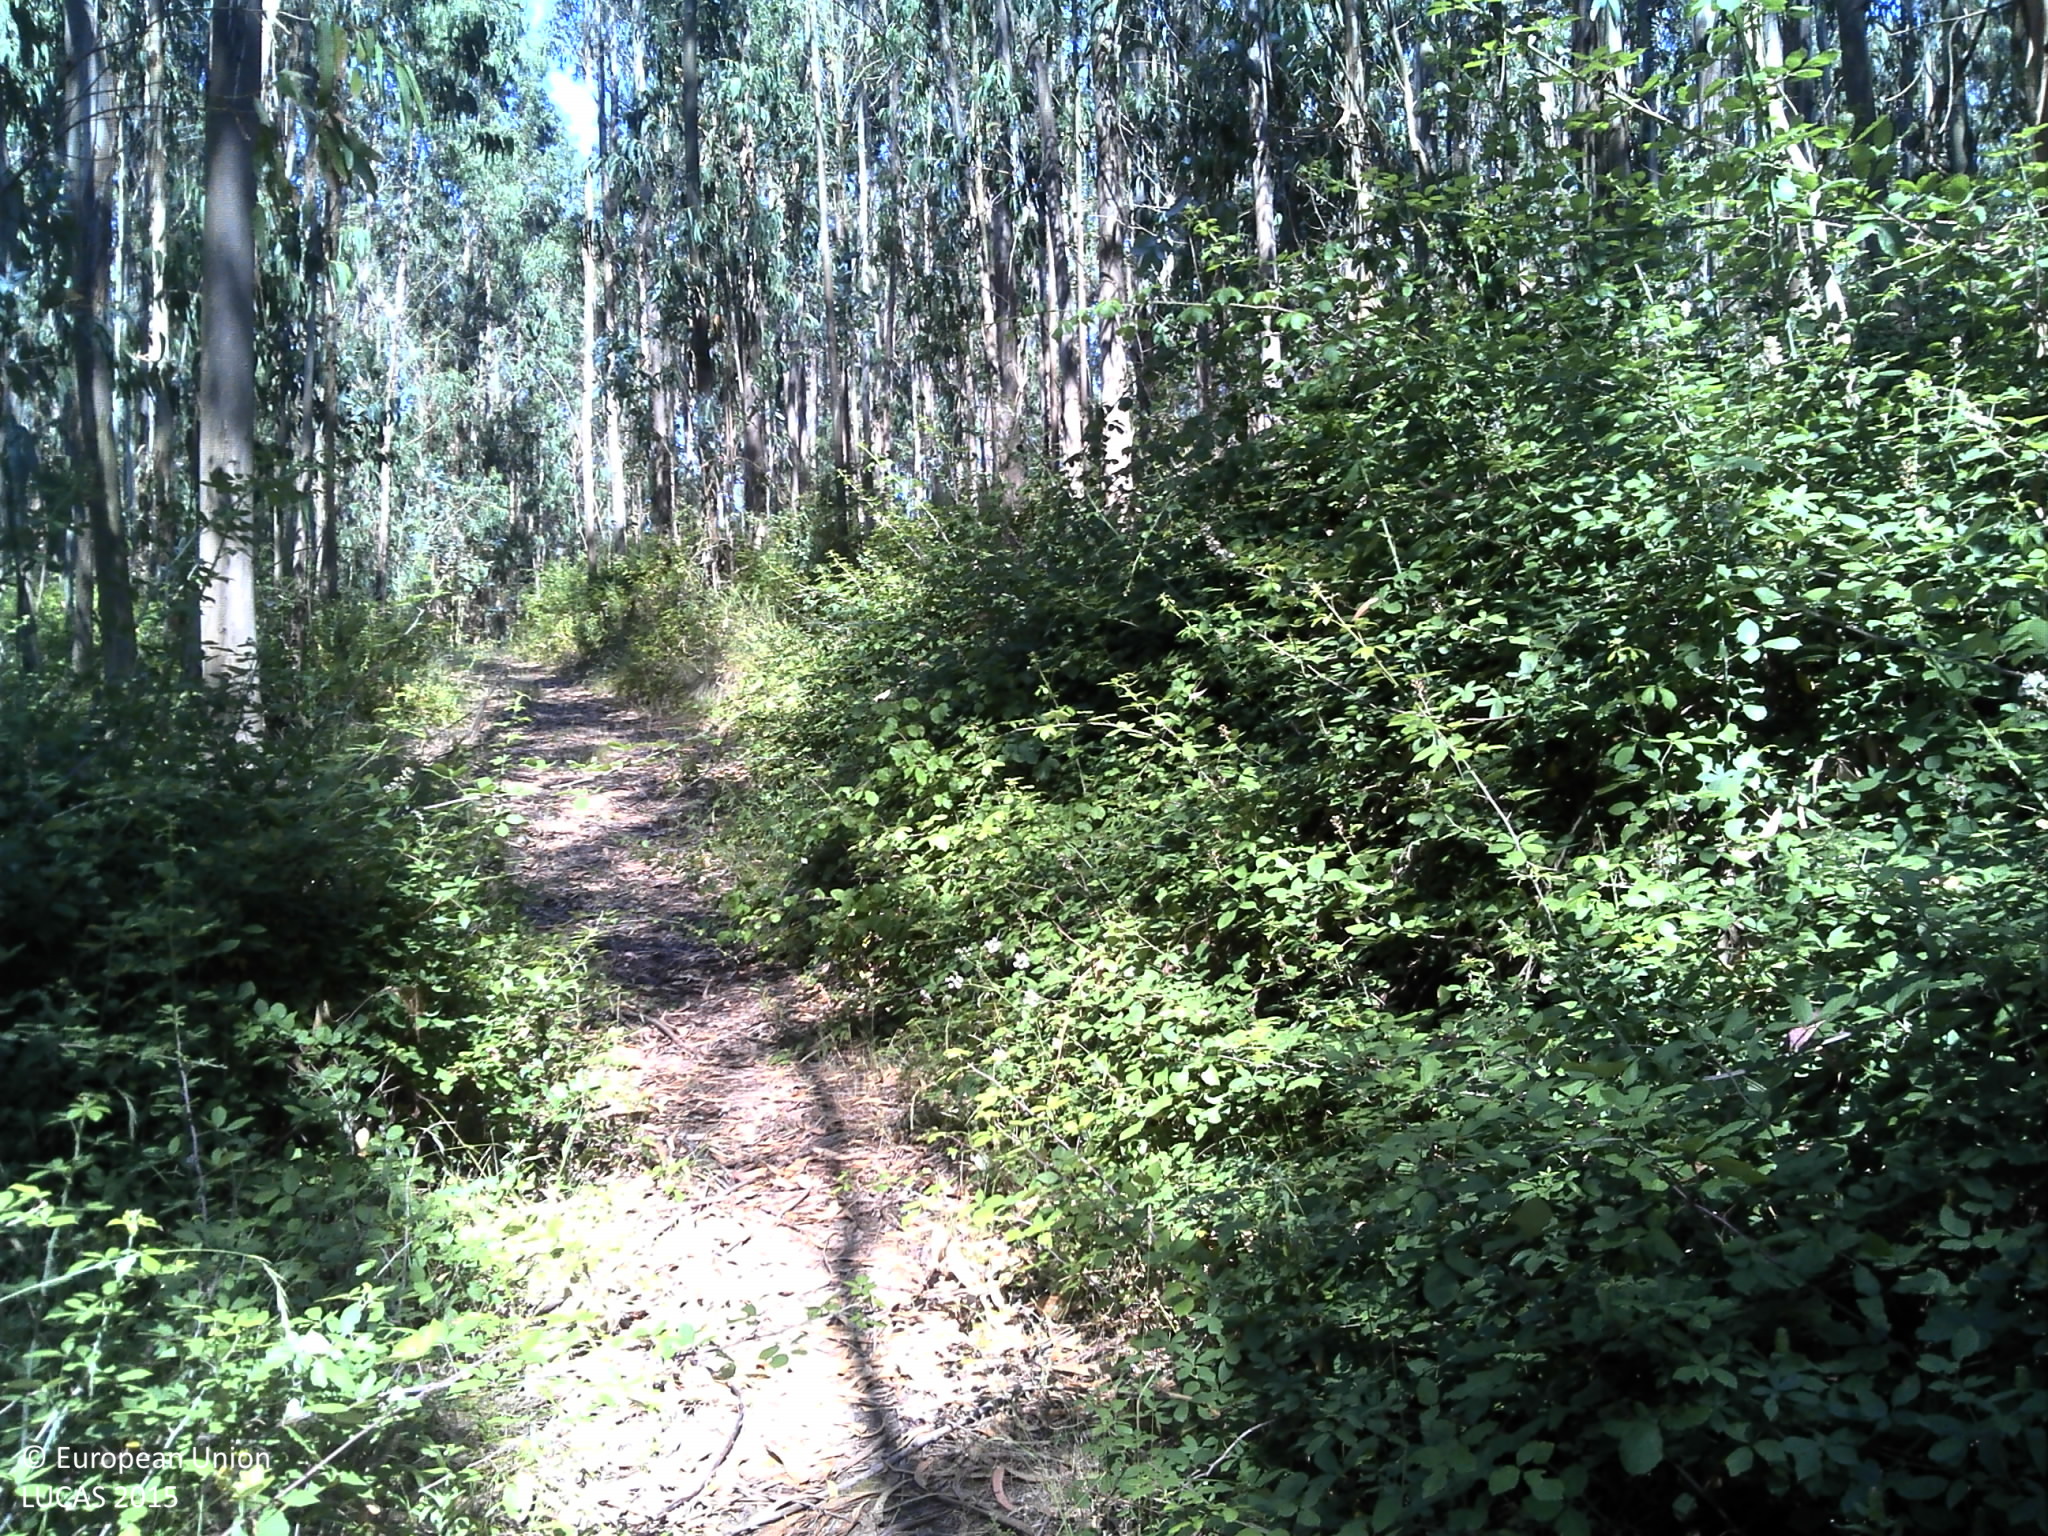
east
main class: Woodland
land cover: Broadleaved woodland
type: exotic forest
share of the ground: > 75 %
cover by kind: broadleaved forest trees 80 %, shrubs 10 %, unconsolidated bare surface 10 %
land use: Forestry
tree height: > 5 m
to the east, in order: Broadleaved woodland; Tracks; Other bare soil
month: June
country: PT
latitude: 39.2107
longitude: -9.2553
